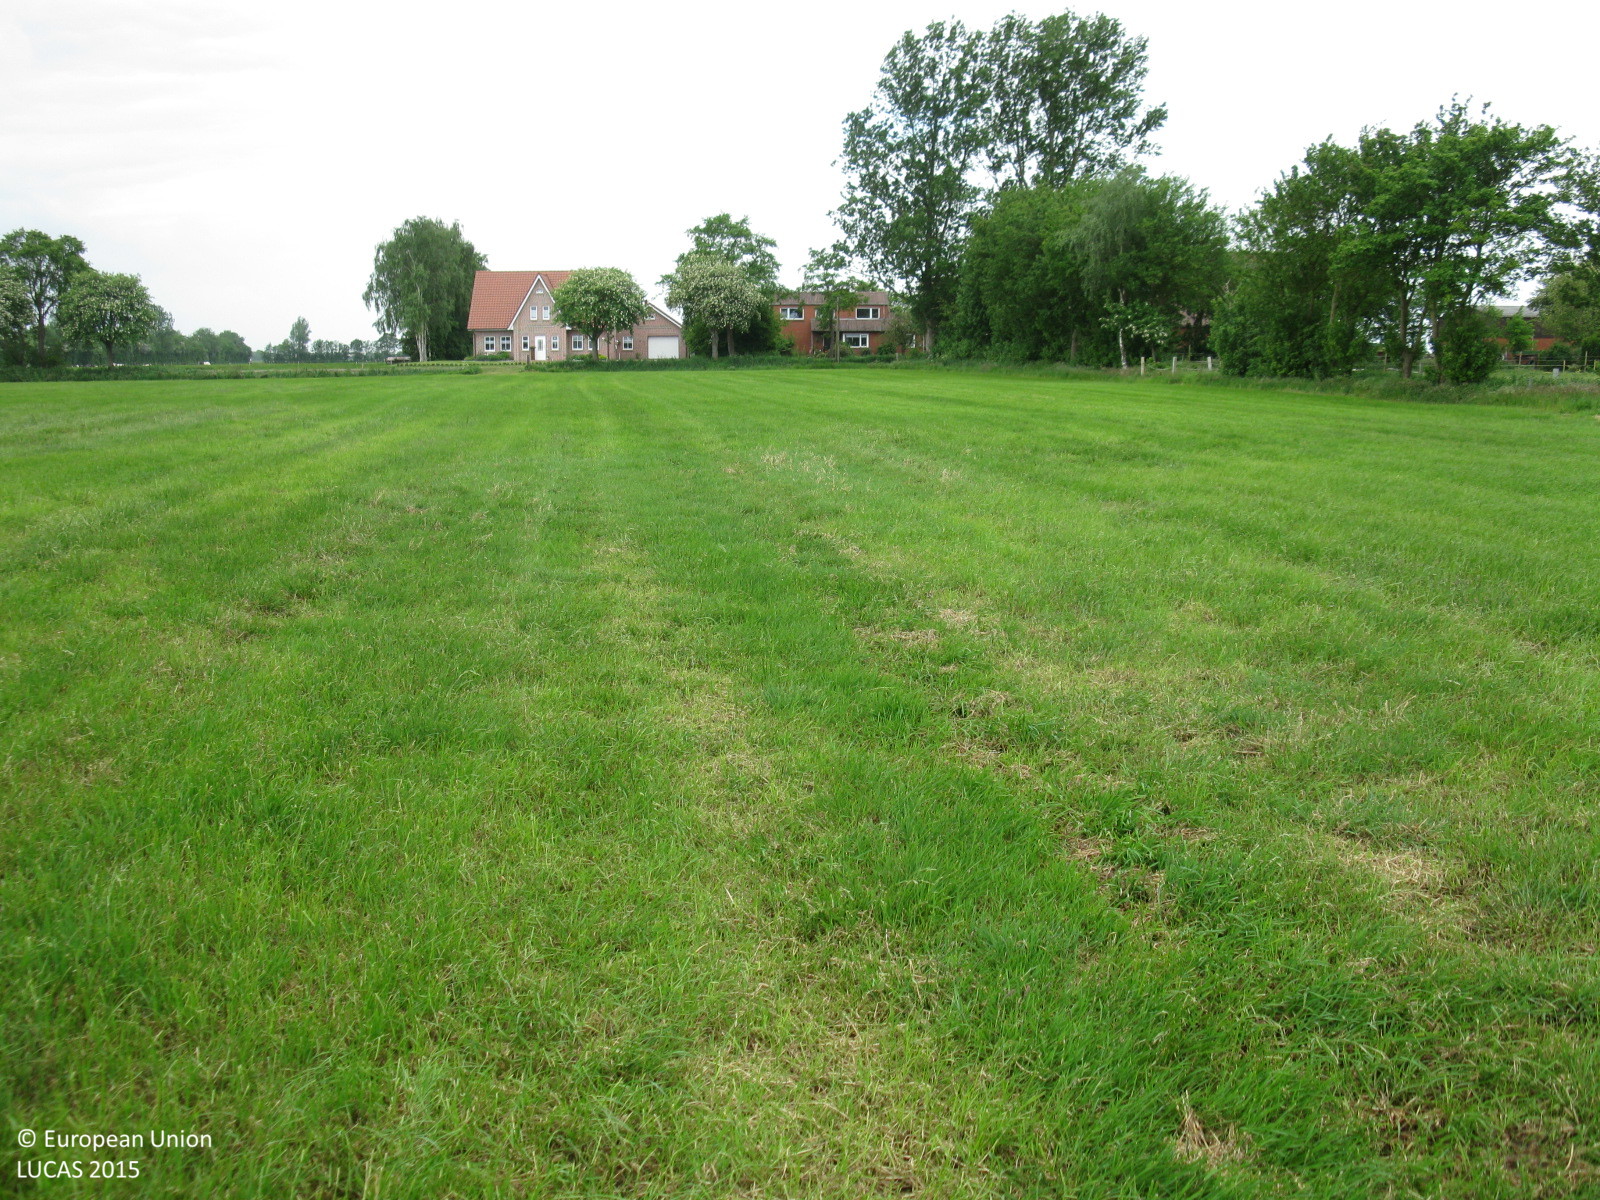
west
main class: Grassland
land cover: Grassland without tree/shrub cover
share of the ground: > 75 %
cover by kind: herbaceous plants 100 %
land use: Agriculture (excluding fallow land and kitchen gardens)
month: June
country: DE
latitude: 53.1406
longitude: 7.4143
